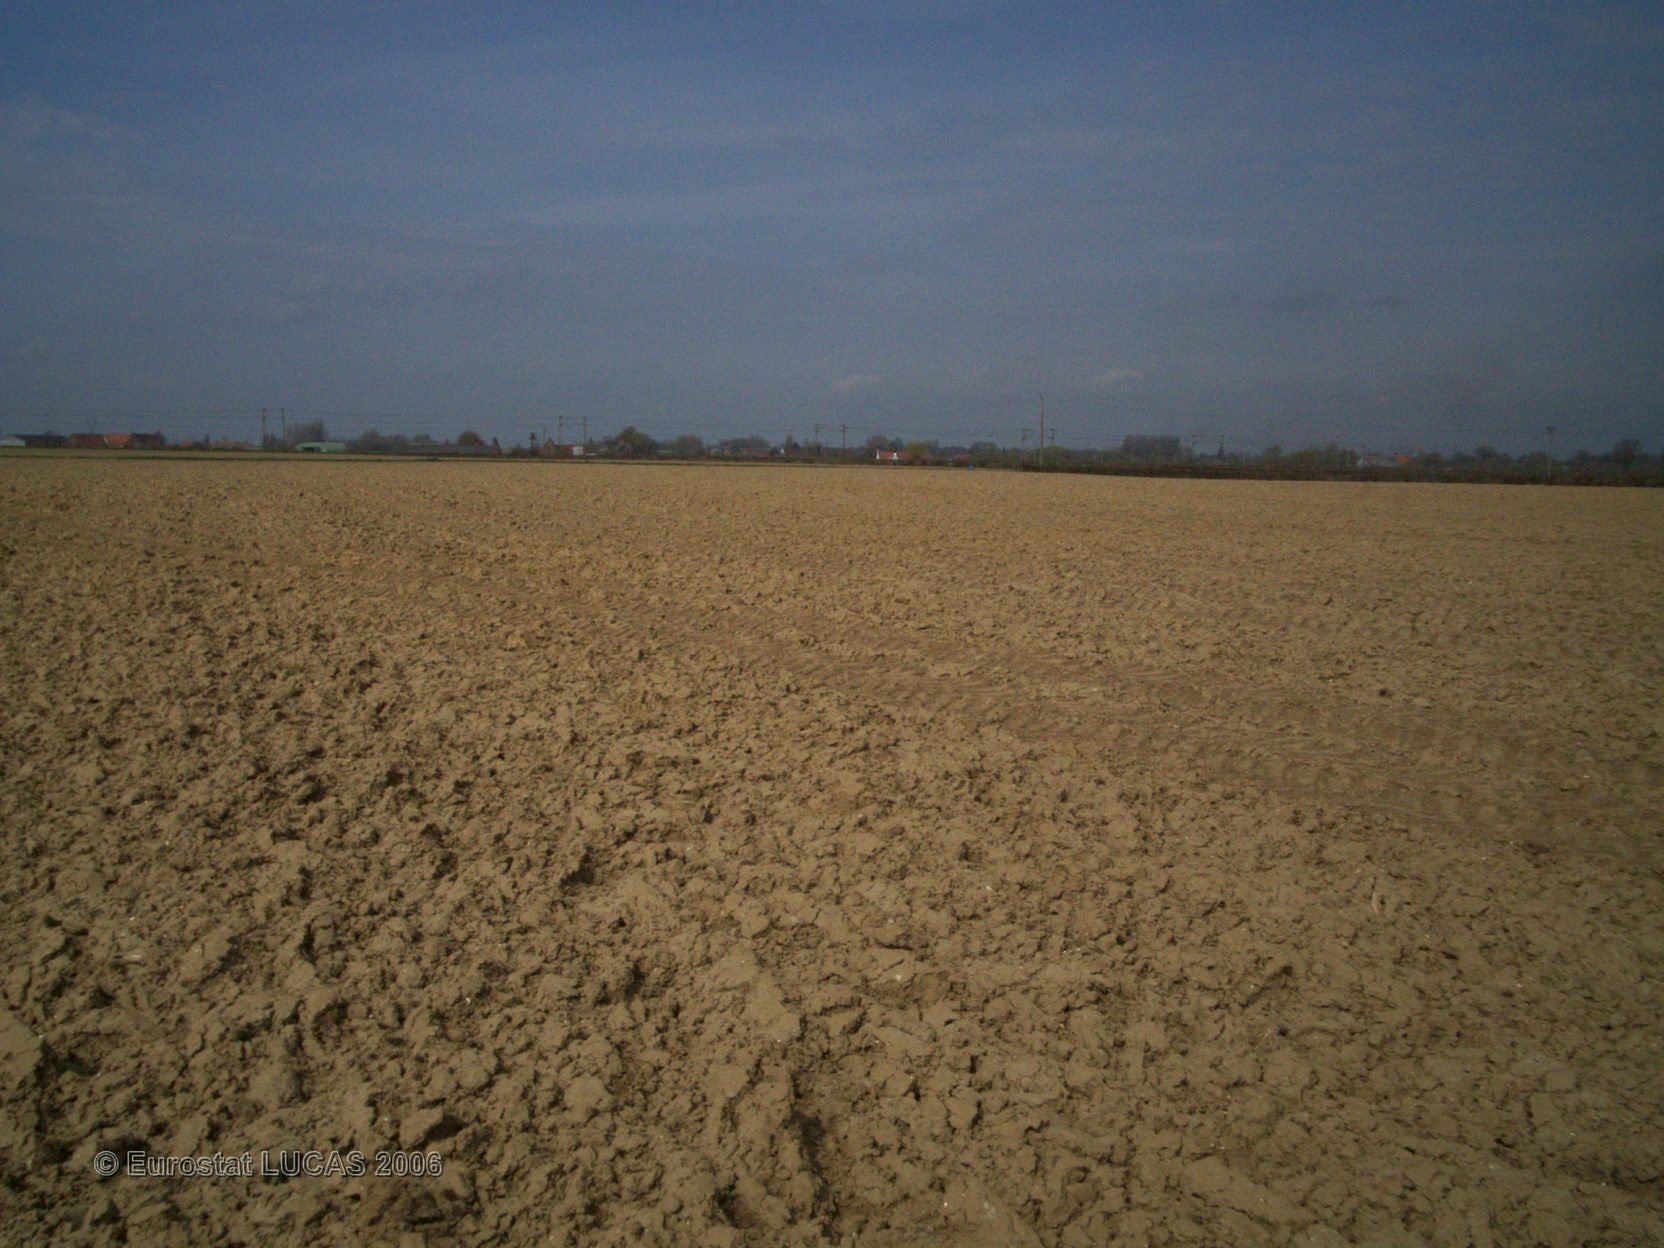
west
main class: Cropland
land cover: Potatoes
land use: Agriculture (excluding fallow land and kitchen gardens)
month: May
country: FR
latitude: 50.7669
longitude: 2.4867
